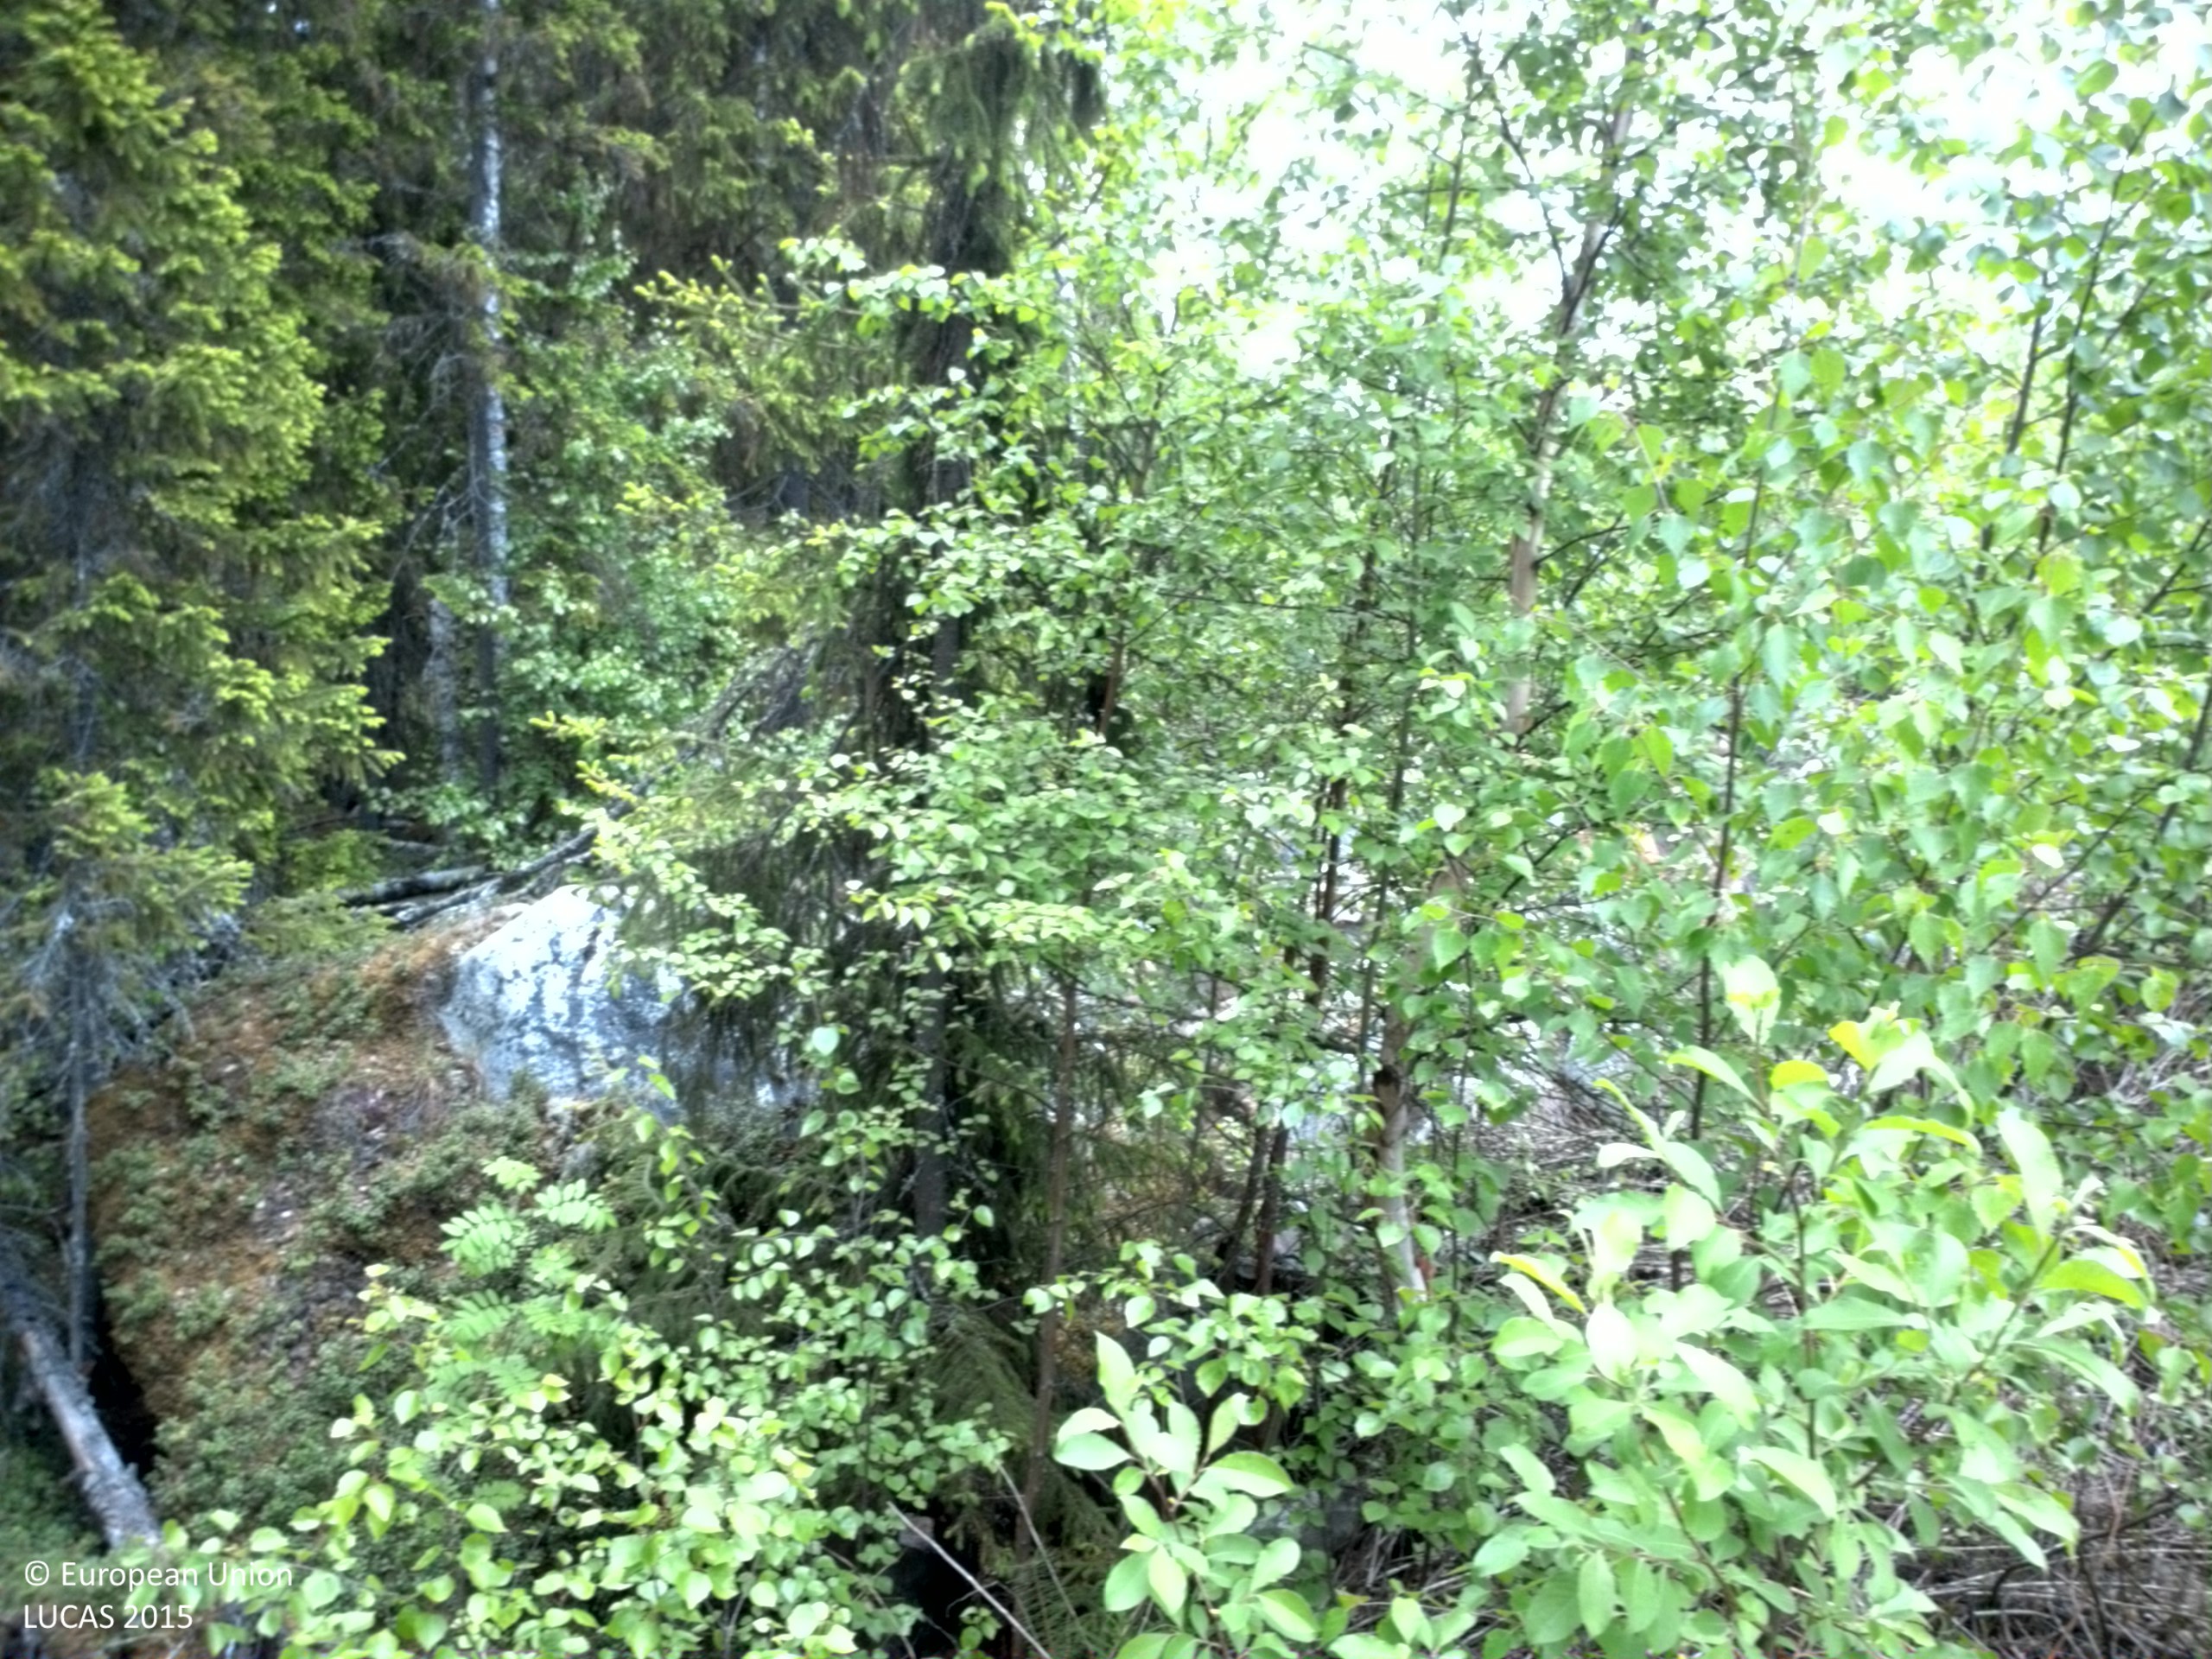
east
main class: Woodland
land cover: Broadleaved woodland
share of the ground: > 75 %
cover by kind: broadleaved forest trees 75 %, shrubs 15 %, coniferous forest trees 5 %, lichens and mosses 5 %
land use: Forestry
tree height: < 5 m
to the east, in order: Broadleaved woodland; Electric lines; Broadleaved woodland; Paved roads, cycling and walking lanes; Broadleaved woodland; Rocks and stones; Electric lines; Railways
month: June
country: SE
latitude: 63.1707
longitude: 17.8212
